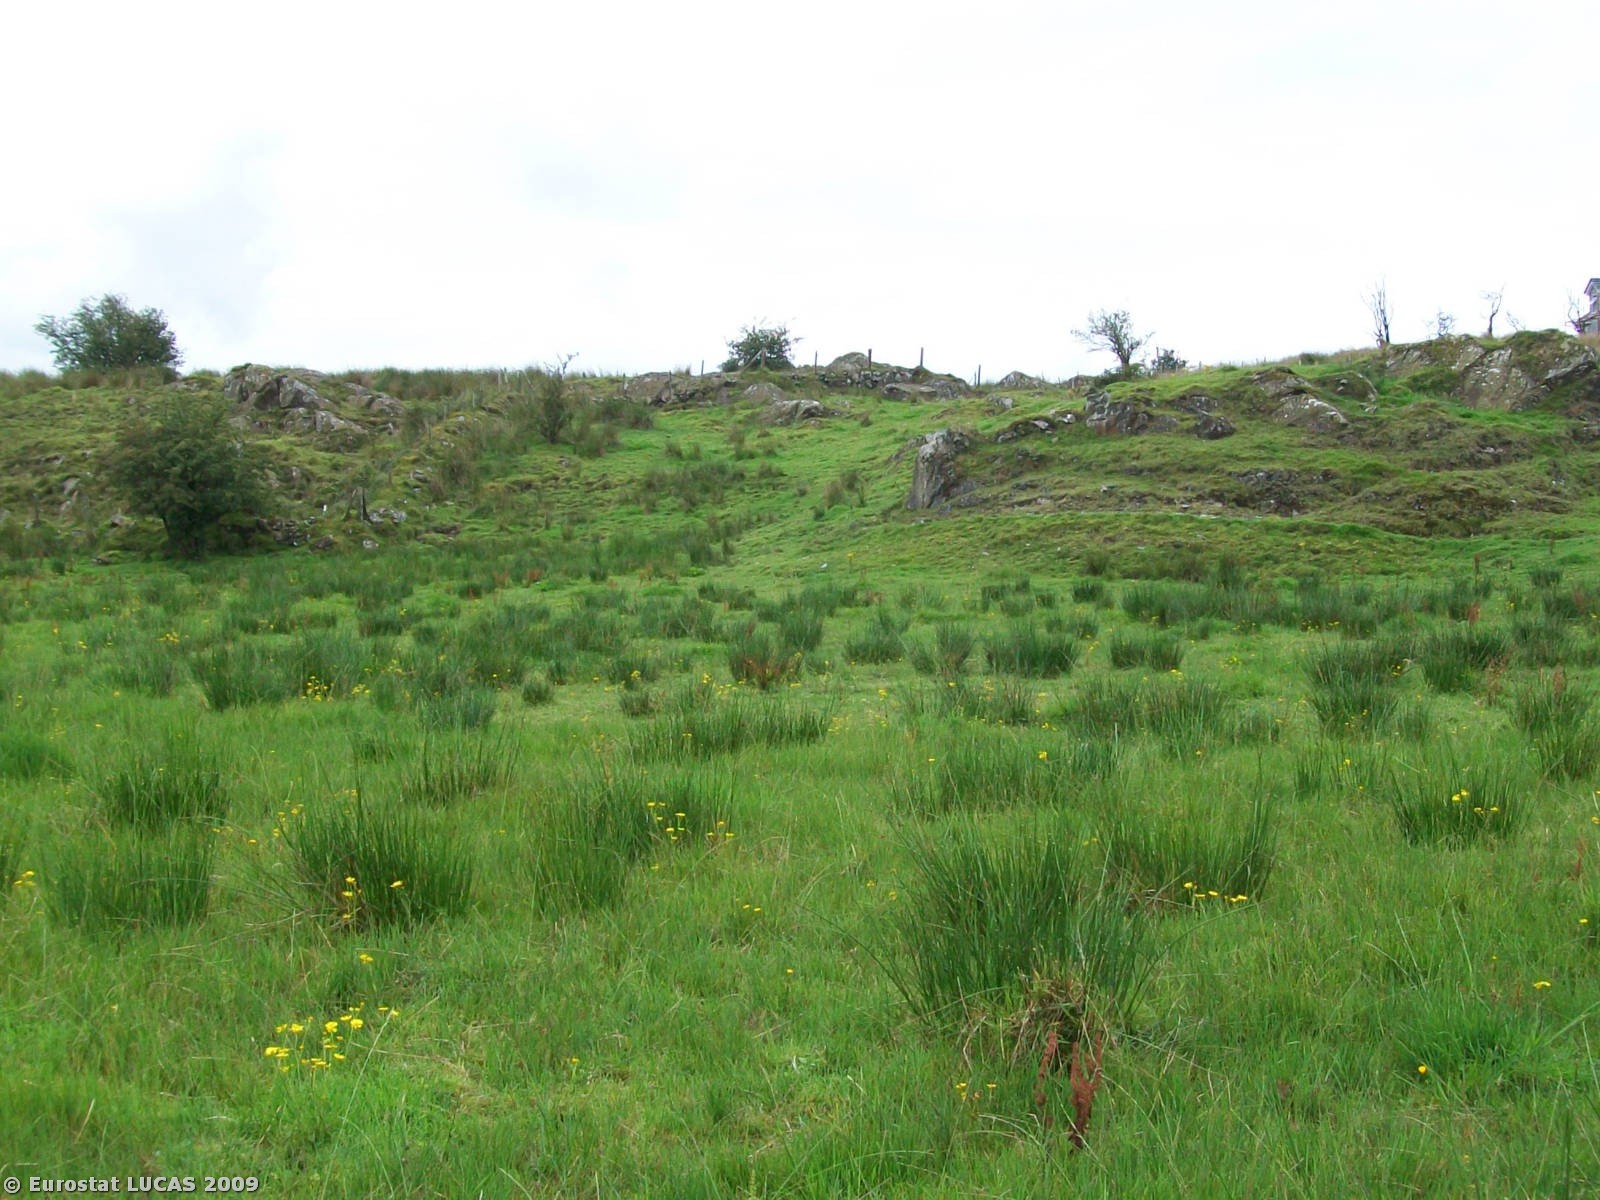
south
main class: Grassland
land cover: Grassland without tree/shrub cover
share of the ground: > 75 %
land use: Agriculture (excluding fallow land and kitchen gardens)
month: August
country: GB
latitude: 54.2152
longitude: -6.7084
